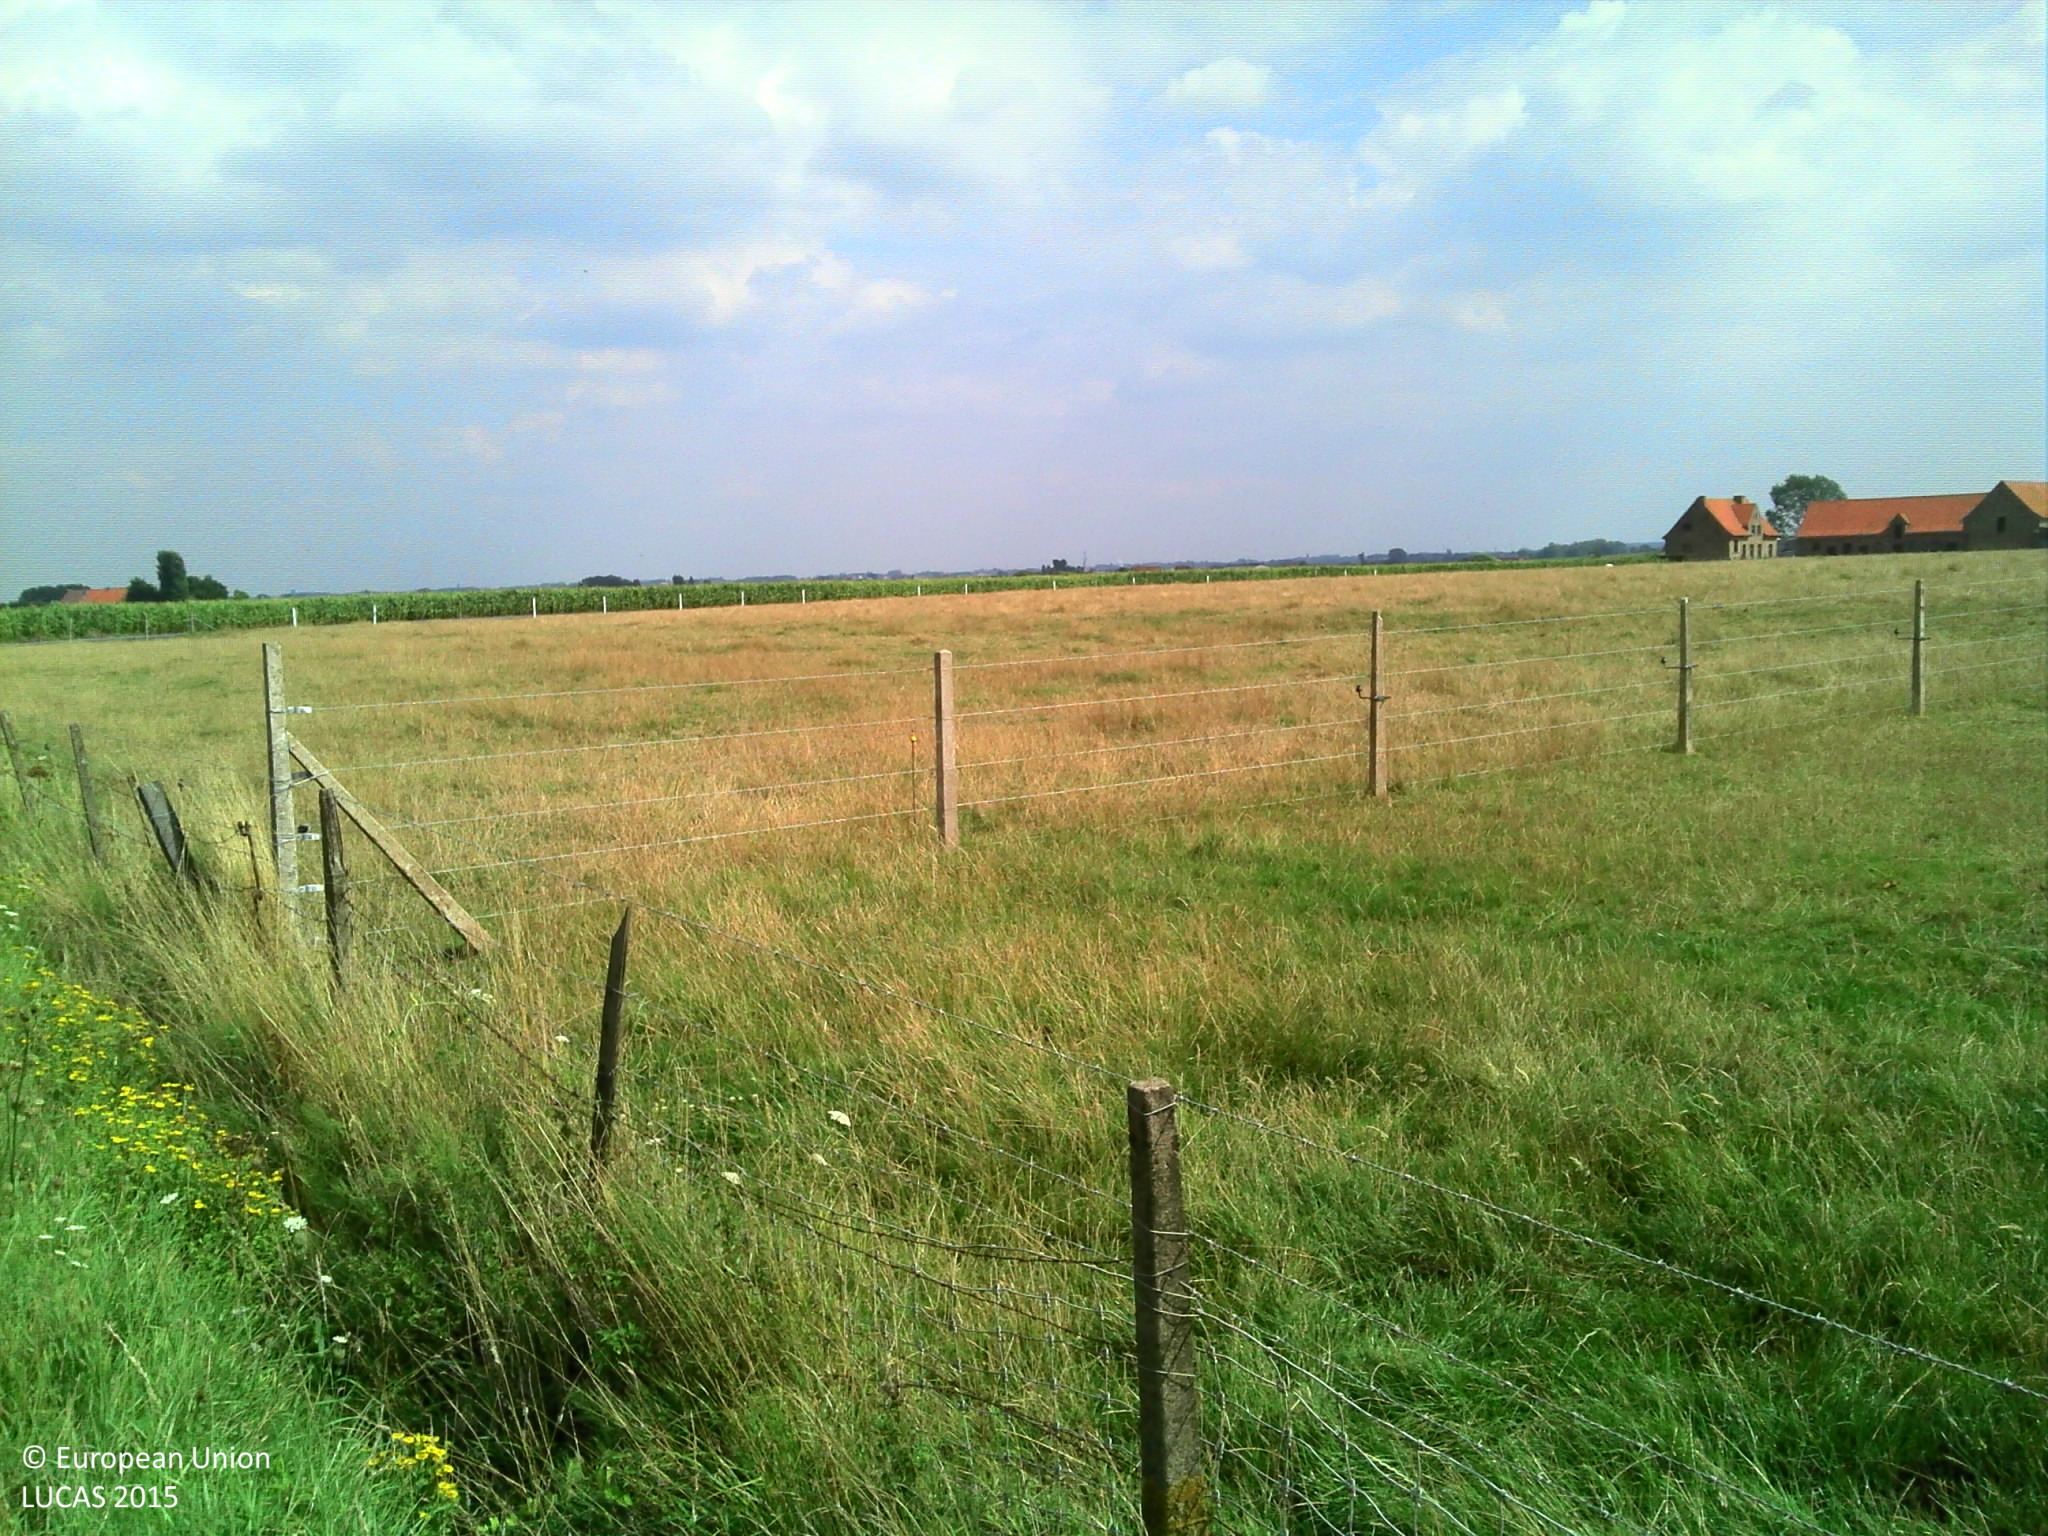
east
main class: Grassland
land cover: Grassland without tree/shrub cover
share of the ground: > 75 %
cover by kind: herbaceous plants 100 %
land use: Agriculture (excluding fallow land and kitchen gardens)
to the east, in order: Grassland without tree/shrub cover; Fences; Paved roads, cycling and walking lanes; Grass margins; Maize
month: August
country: BE
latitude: 50.9011
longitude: 2.8939
